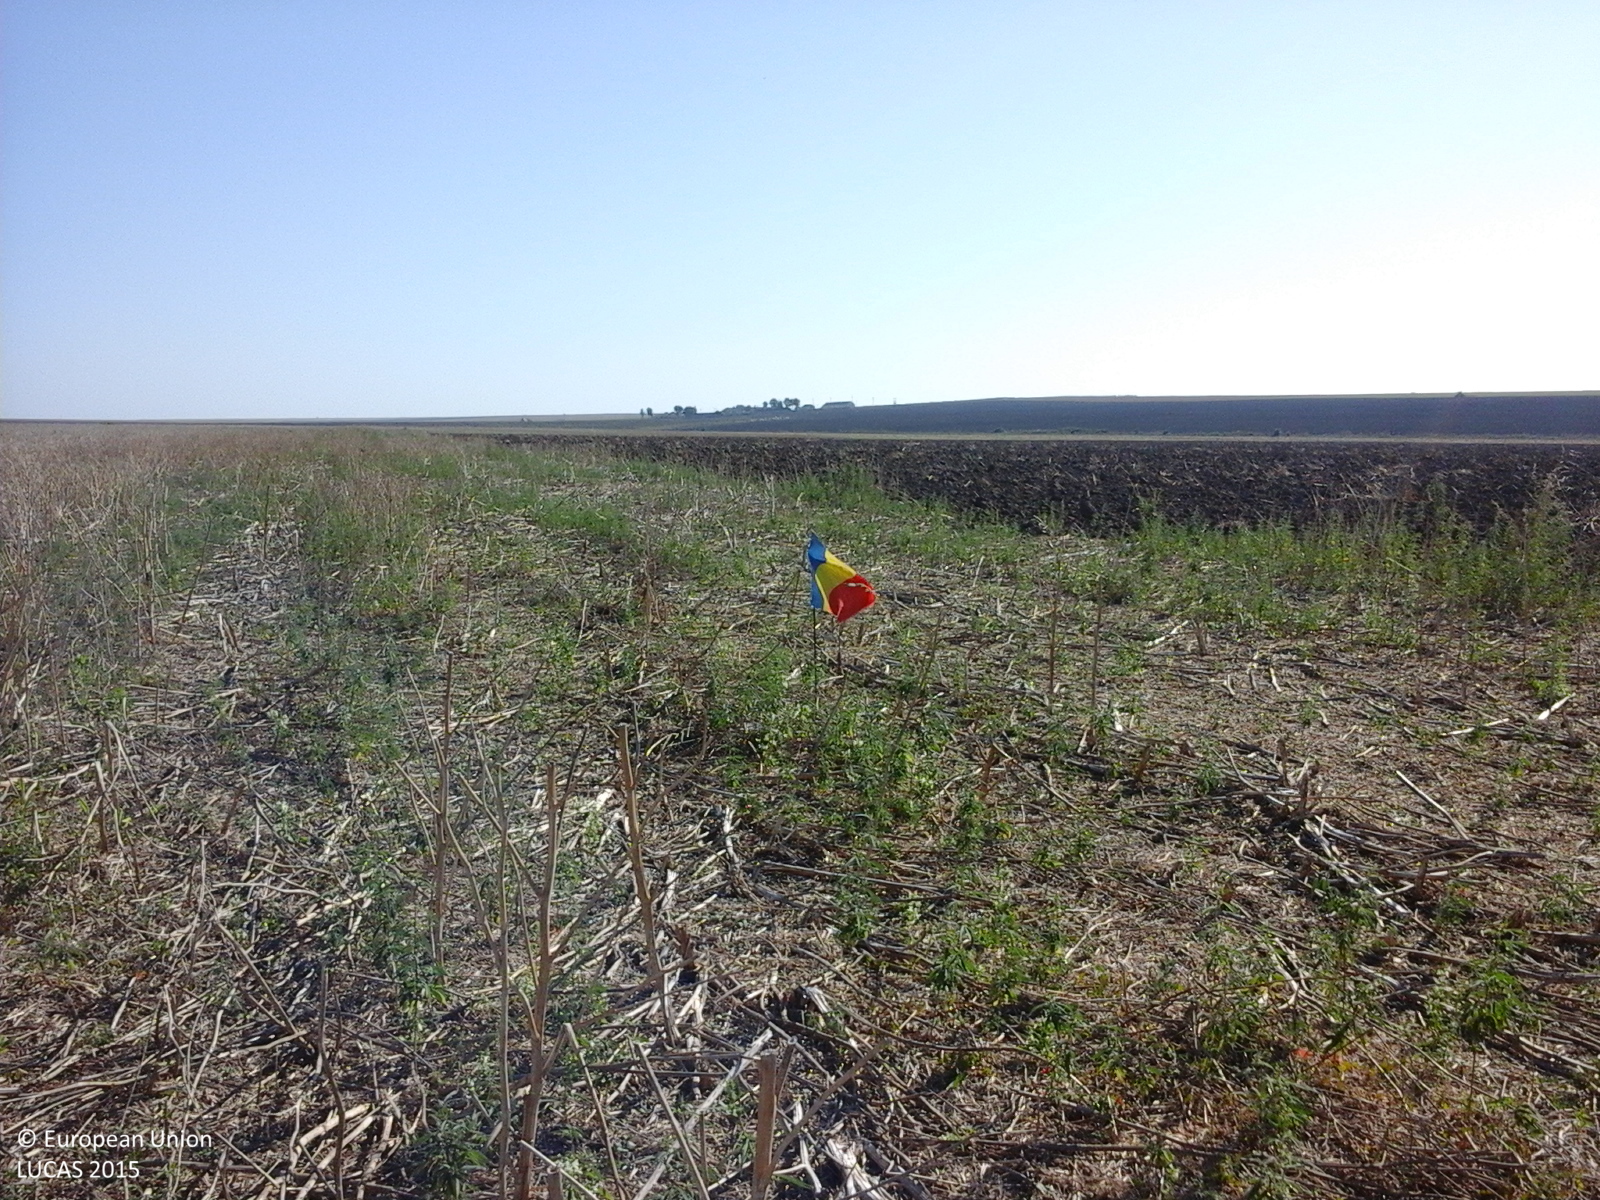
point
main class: Cropland
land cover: Rape and turnip rape
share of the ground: 25 - 50 %
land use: Agriculture (excluding fallow land and kitchen gardens)
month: August
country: RO
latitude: 44.2889
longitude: 28.4277
